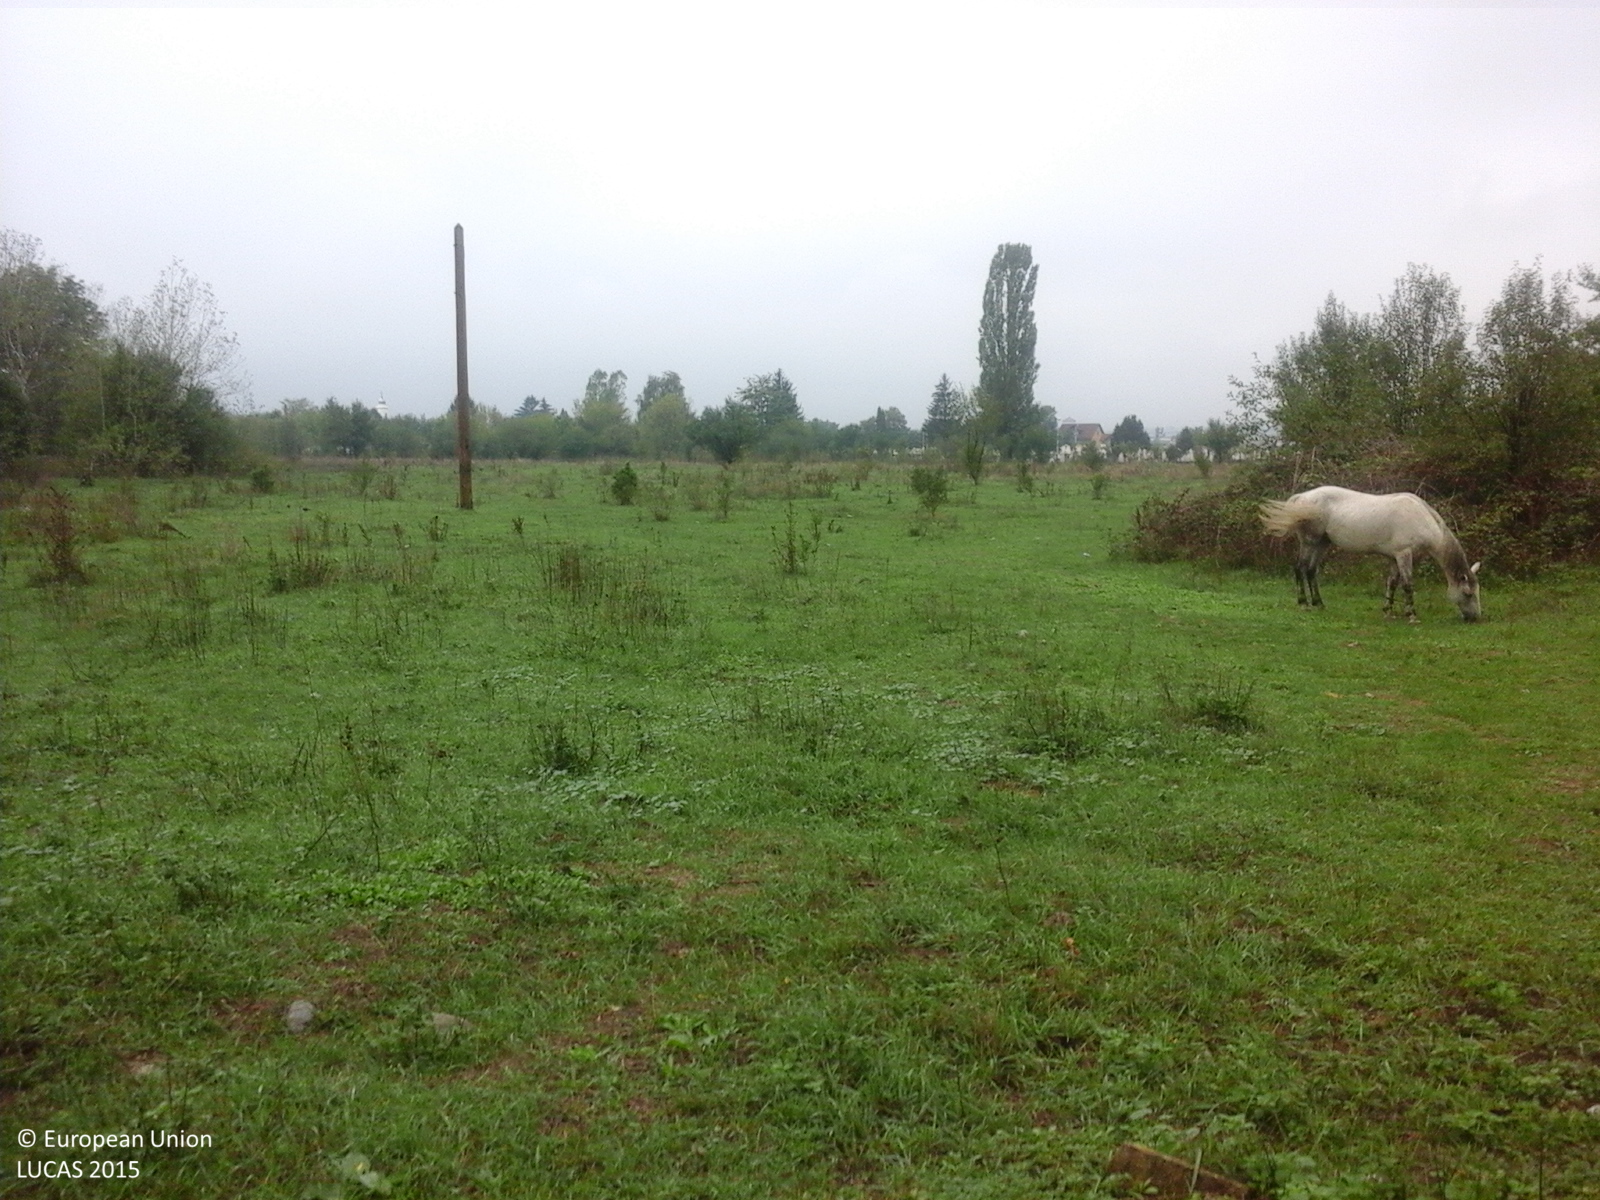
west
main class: Grassland
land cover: Grassland without tree/shrub cover
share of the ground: > 75 %
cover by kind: herbaceous plants 100 %
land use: Agriculture (excluding fallow land and kitchen gardens)
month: September
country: RO
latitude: 45.0424
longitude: 23.2954
